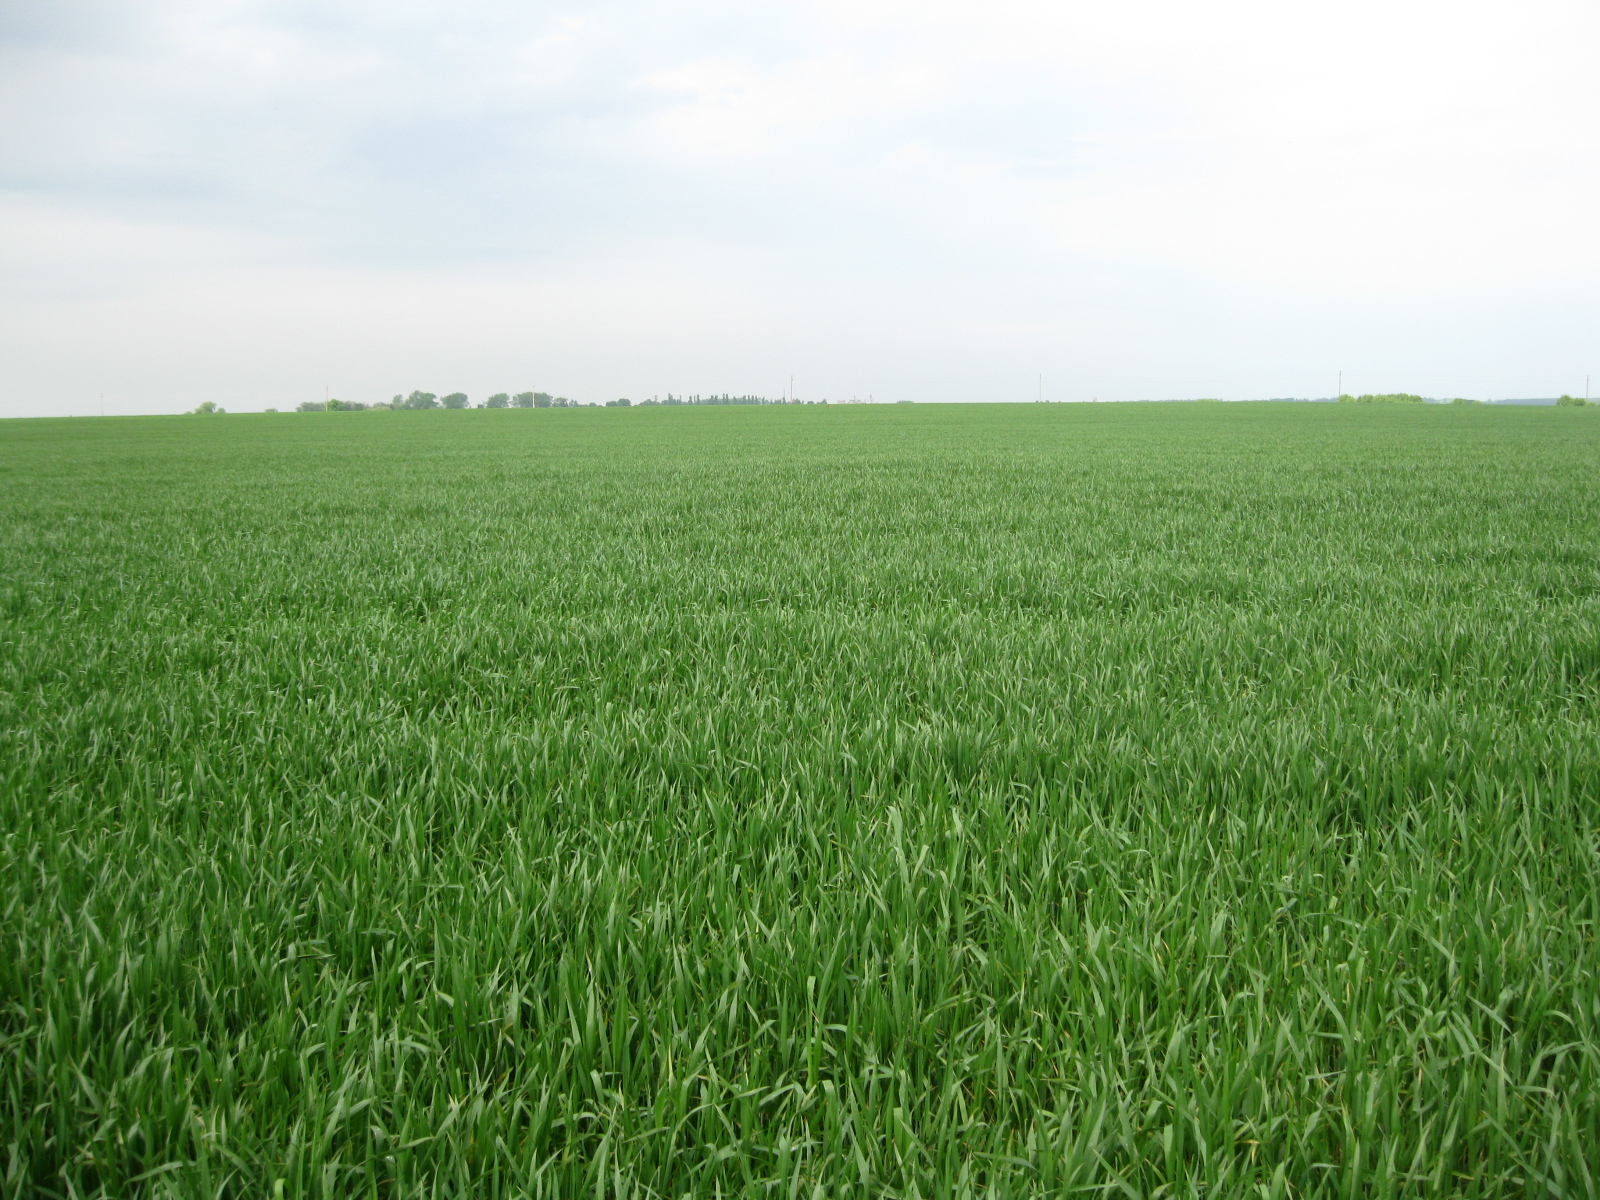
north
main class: Cropland
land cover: Common wheat
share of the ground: > 75 %
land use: Agriculture (excluding fallow land and kitchen gardens)
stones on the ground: < 10 %
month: June
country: LT
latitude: 55.9731
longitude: 24.0776
